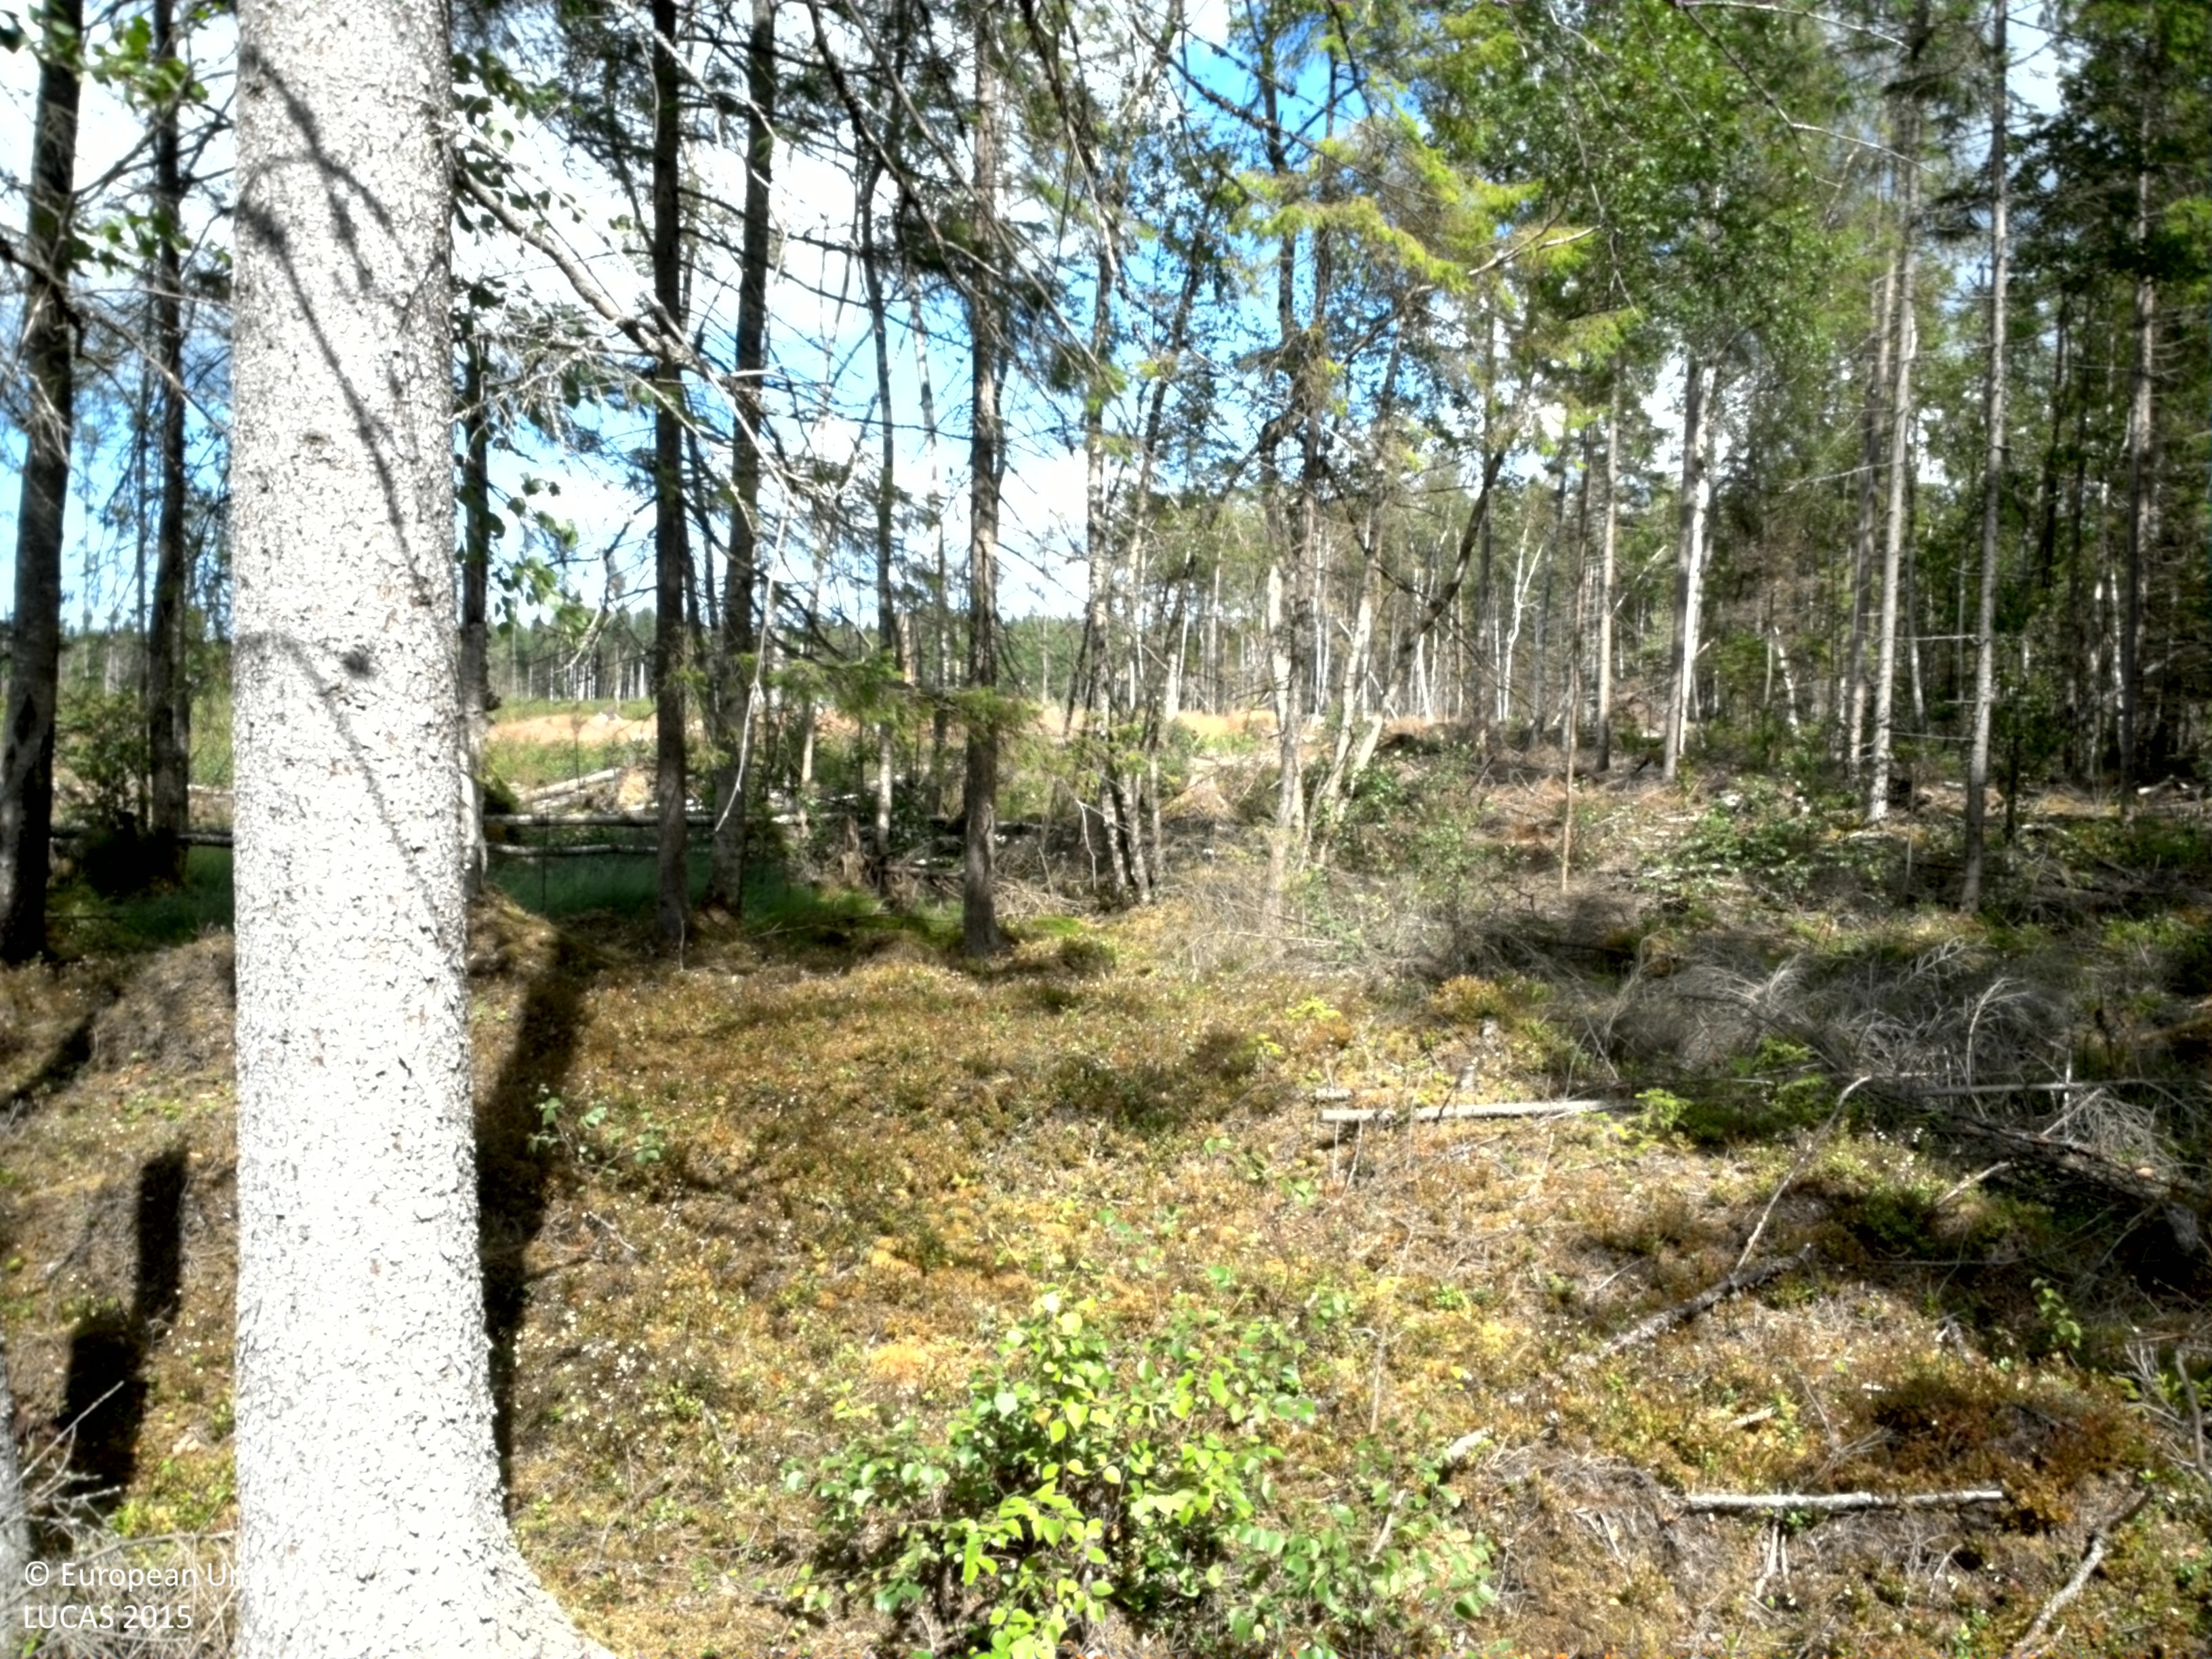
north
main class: Woodland
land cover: Spruce dominated coniferous woodland
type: boreal forest
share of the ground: 10 - 25 %
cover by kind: lichens and mosses 40 %, shrubs 25 %, coniferous forest trees 20 %, unconsolidated bare surface 10 %, broadleaved forest trees 5 %
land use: Forestry
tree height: > 5 m
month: July
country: SE
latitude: 58.7020
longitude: 13.9453
